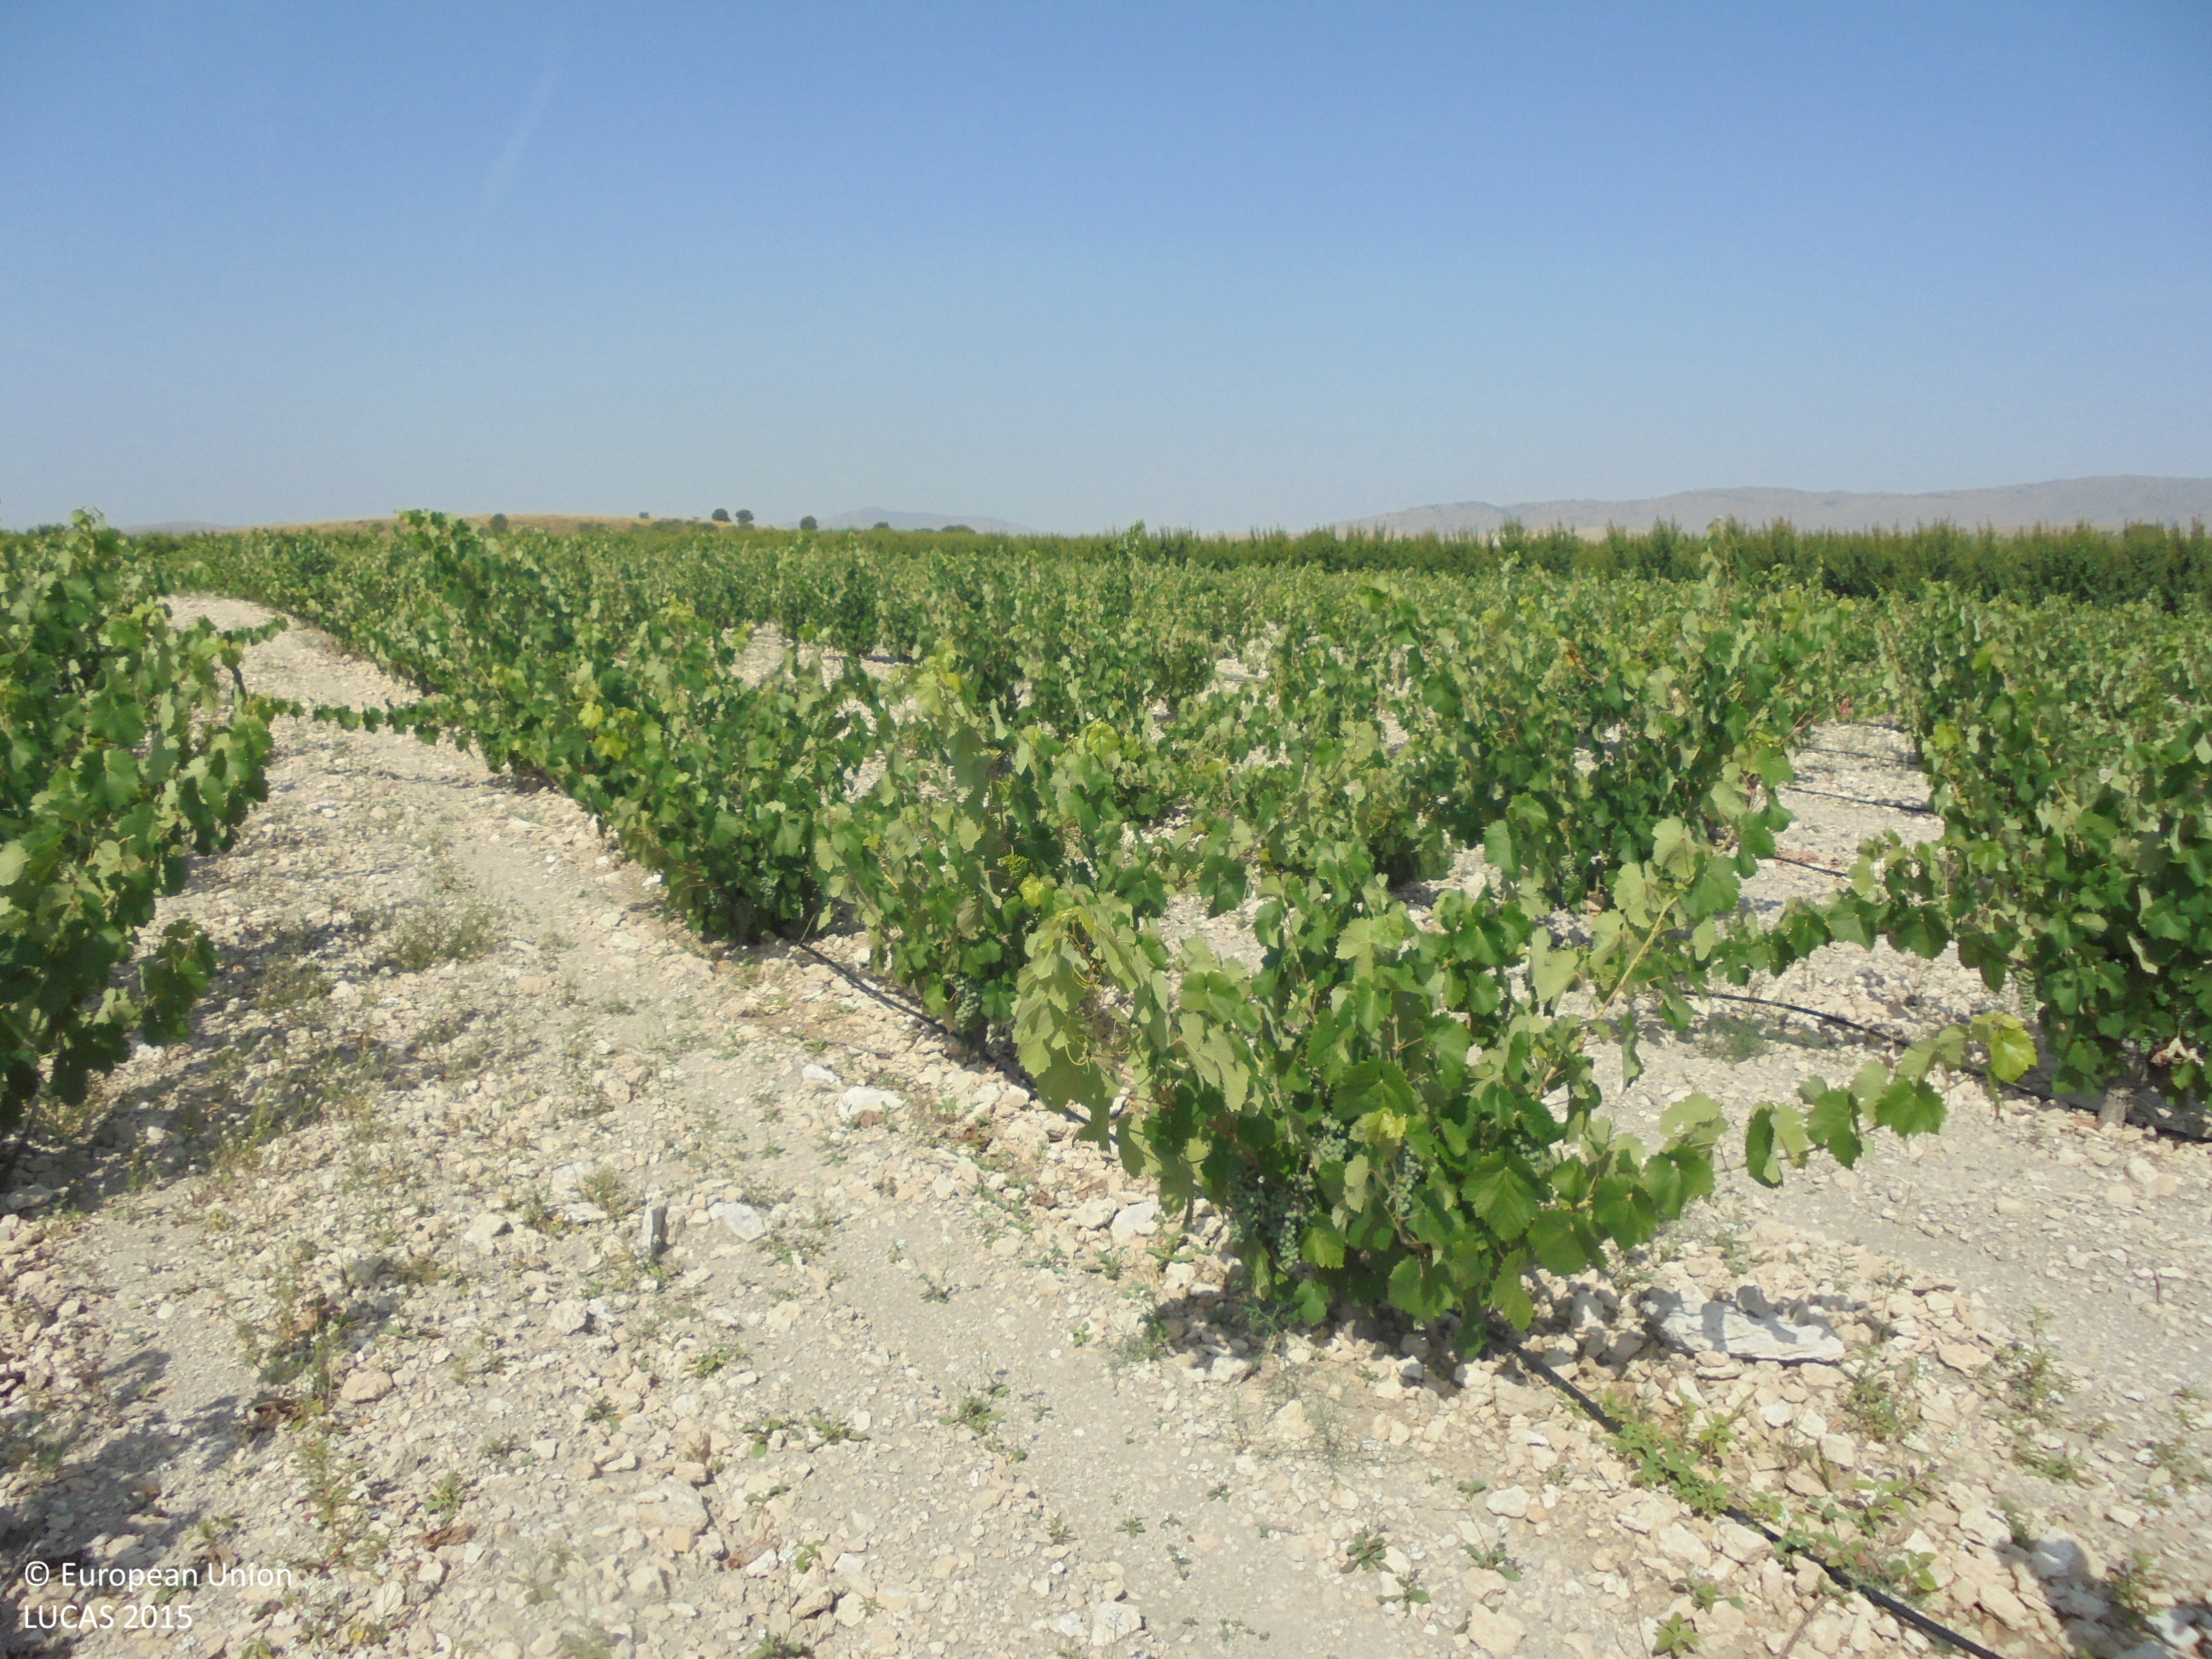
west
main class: Cropland
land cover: Vineyards
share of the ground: 25 - 50 %
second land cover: Spontaneously vegetated surfaces
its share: 25 - 50 %
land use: Agriculture (excluding fallow land and kitchen gardens)
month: July
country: ES
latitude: 38.6024
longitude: -1.6491
